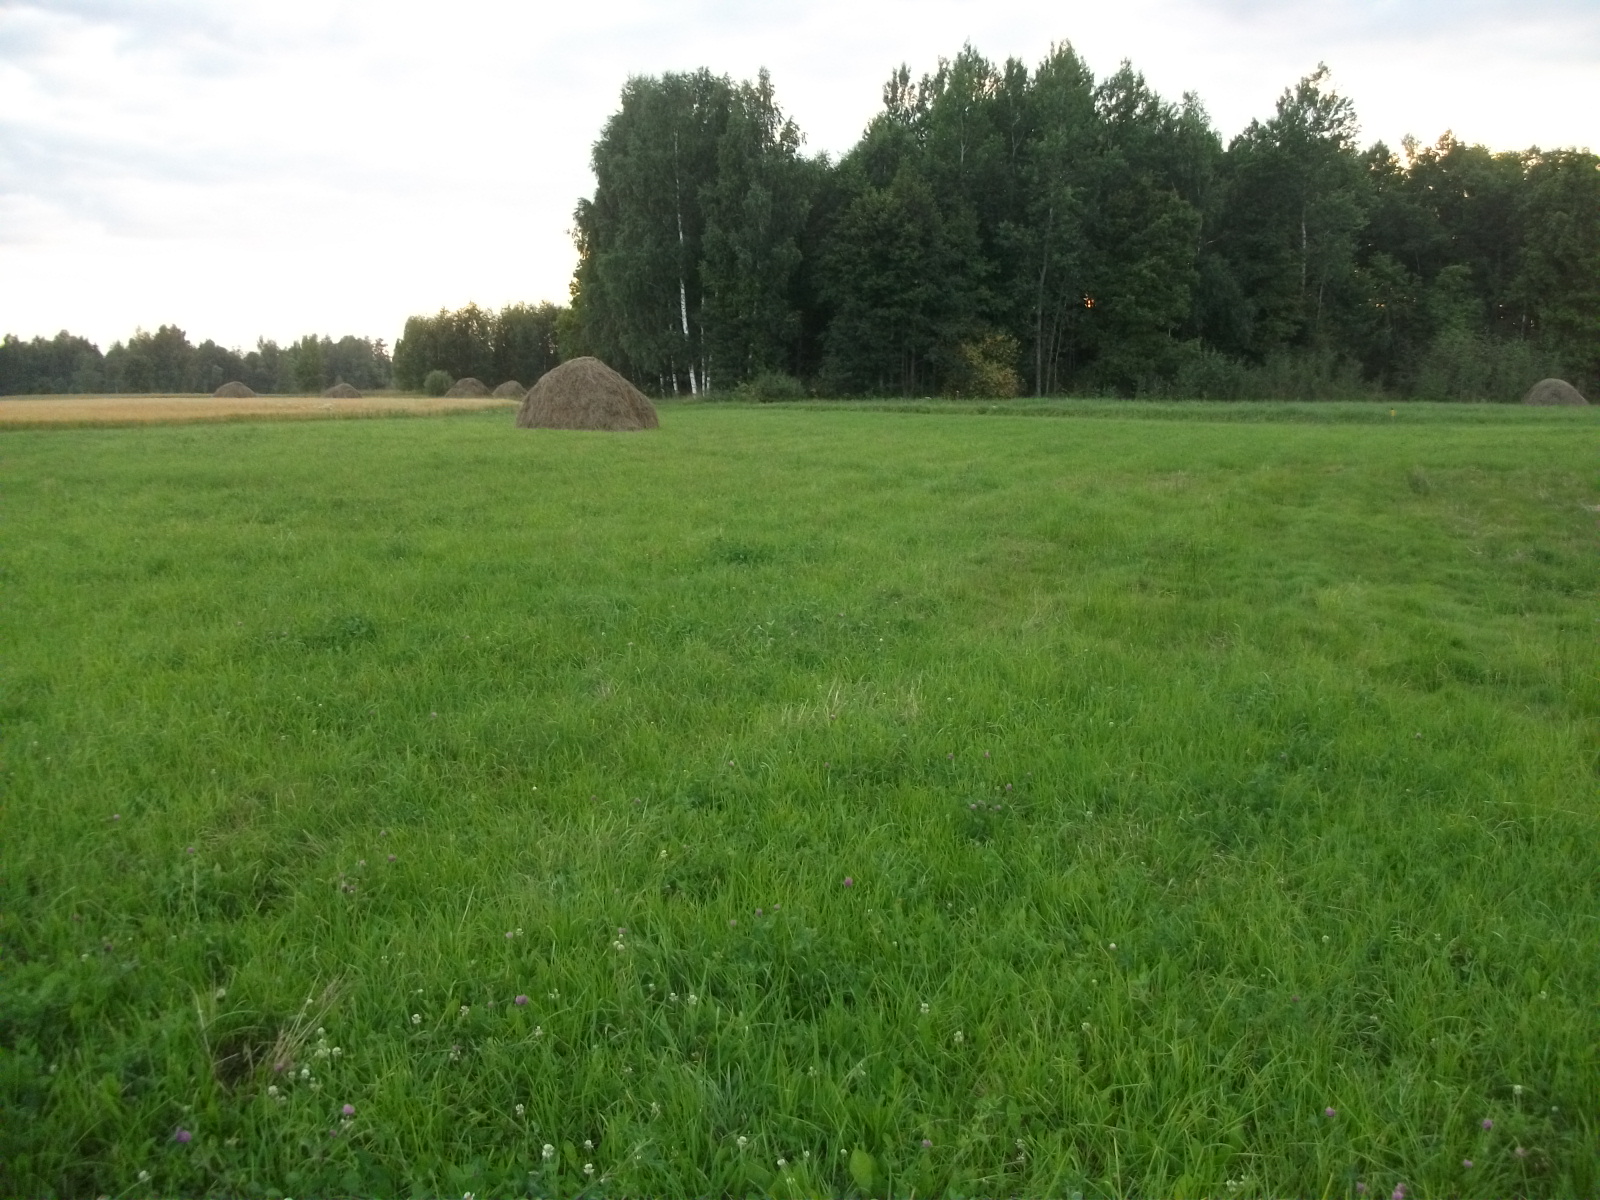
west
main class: Grassland
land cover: Grassland without tree/shrub cover
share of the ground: > 75 %
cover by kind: herbaceous plants 100 %
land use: Agriculture (excluding fallow land and kitchen gardens)
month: August
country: LV
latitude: 56.7446
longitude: 26.5142
